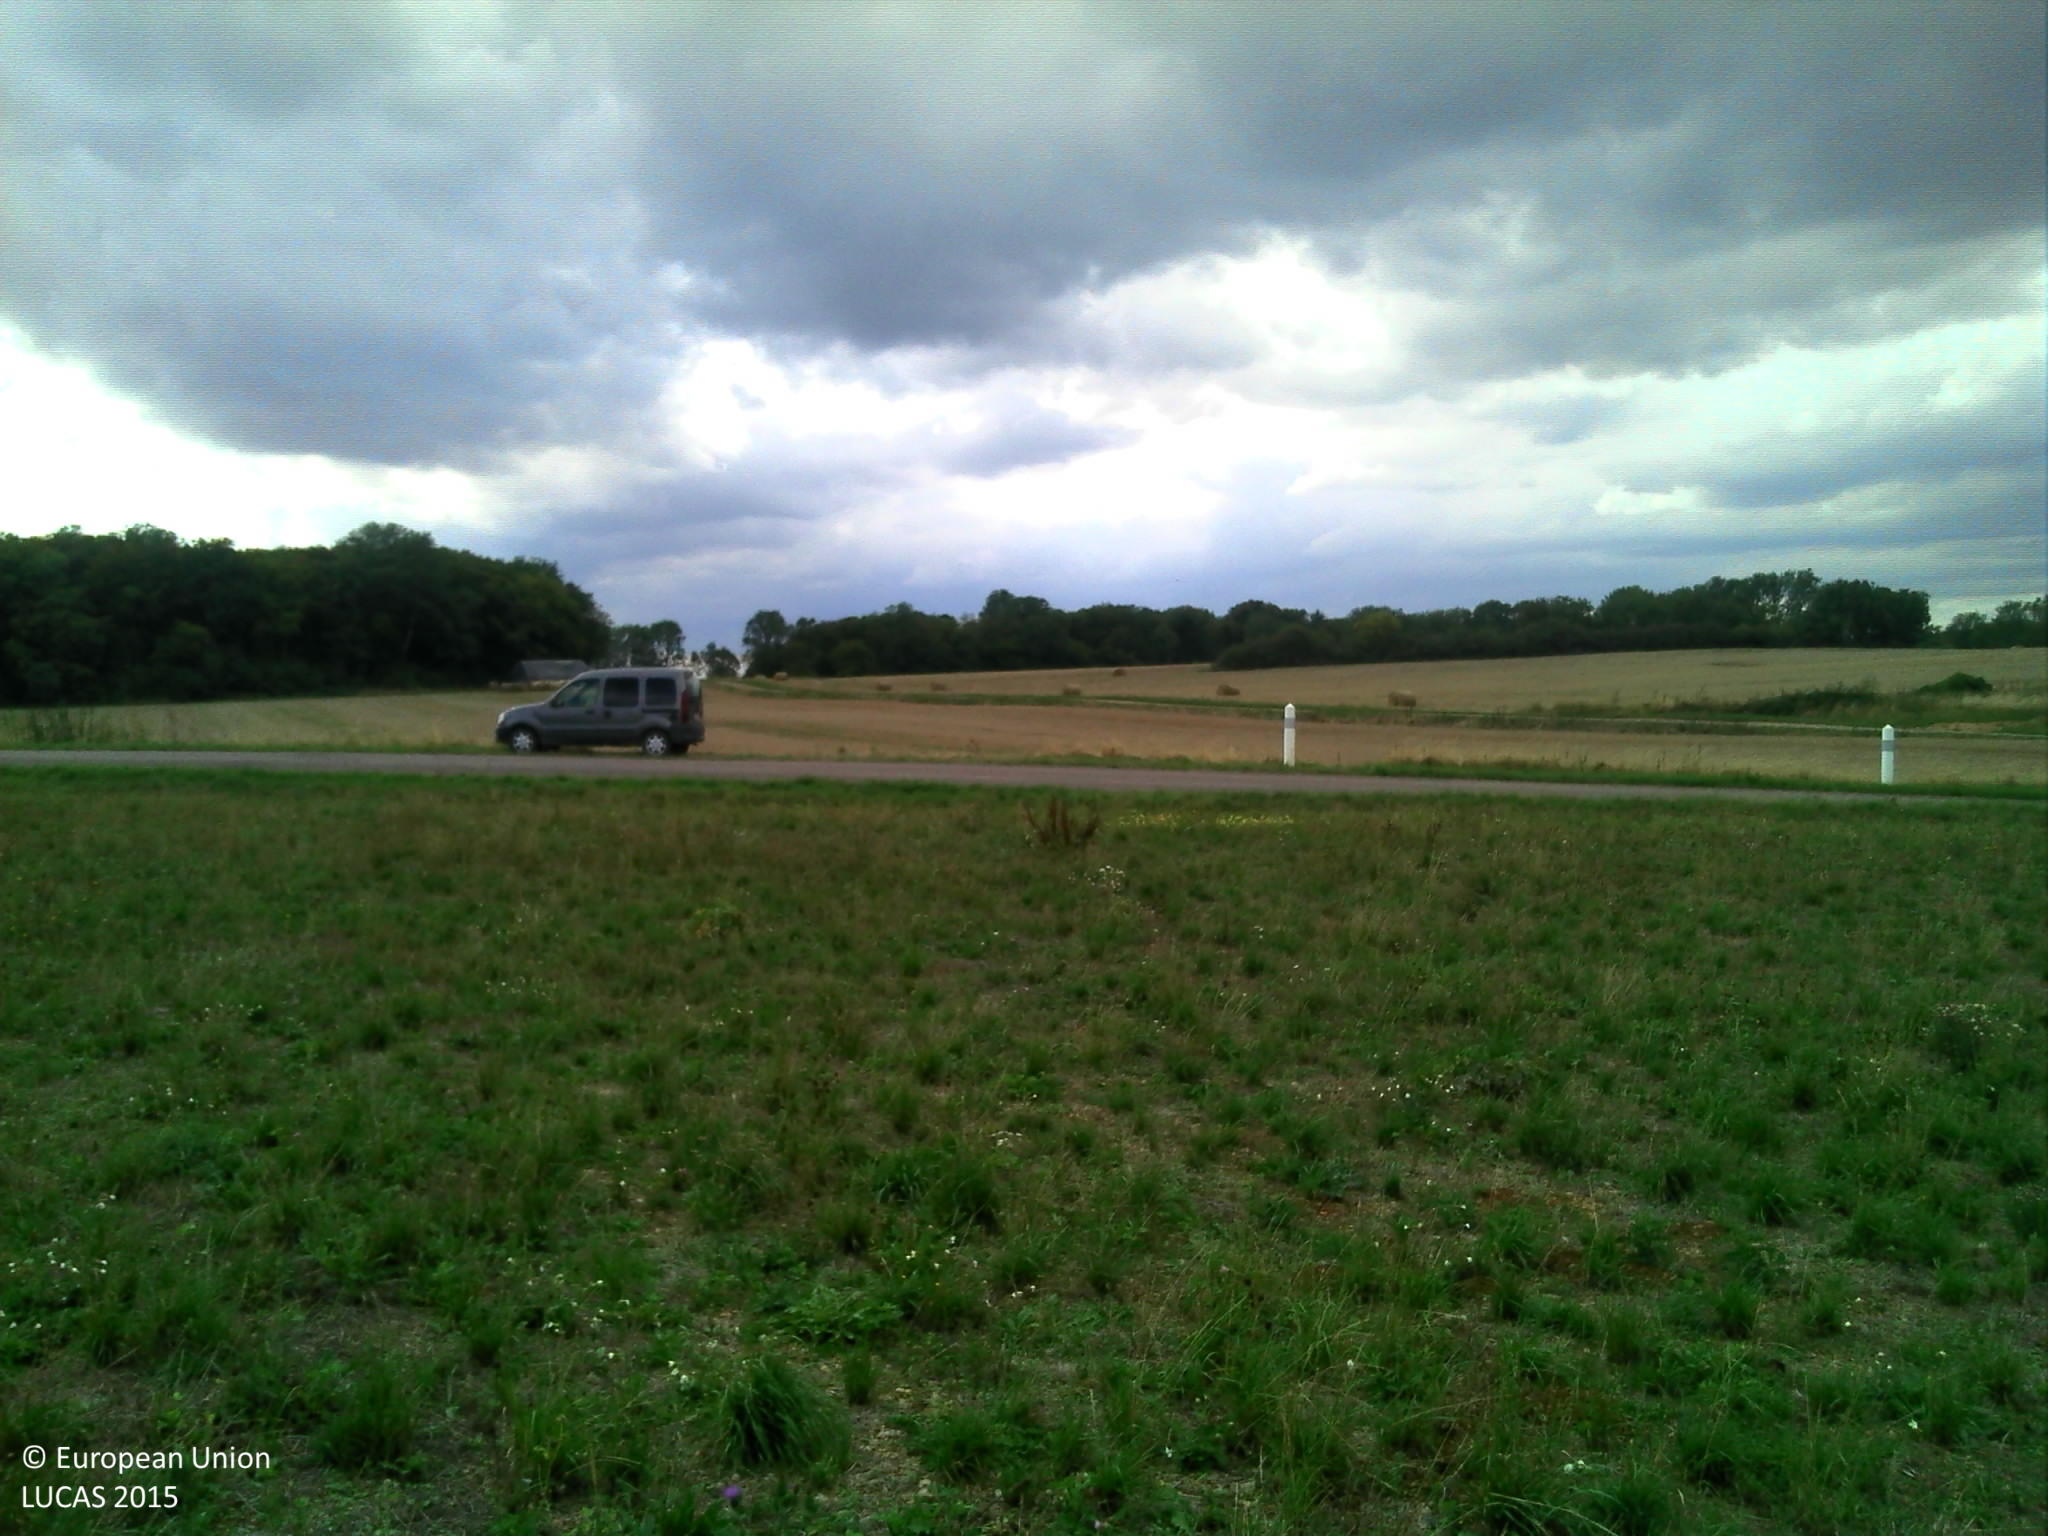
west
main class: Cropland
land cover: Temporary grasslands
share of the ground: > 75 %
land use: Agriculture (excluding fallow land and kitchen gardens)
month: August
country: FR
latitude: 47.3023
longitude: 4.6964
